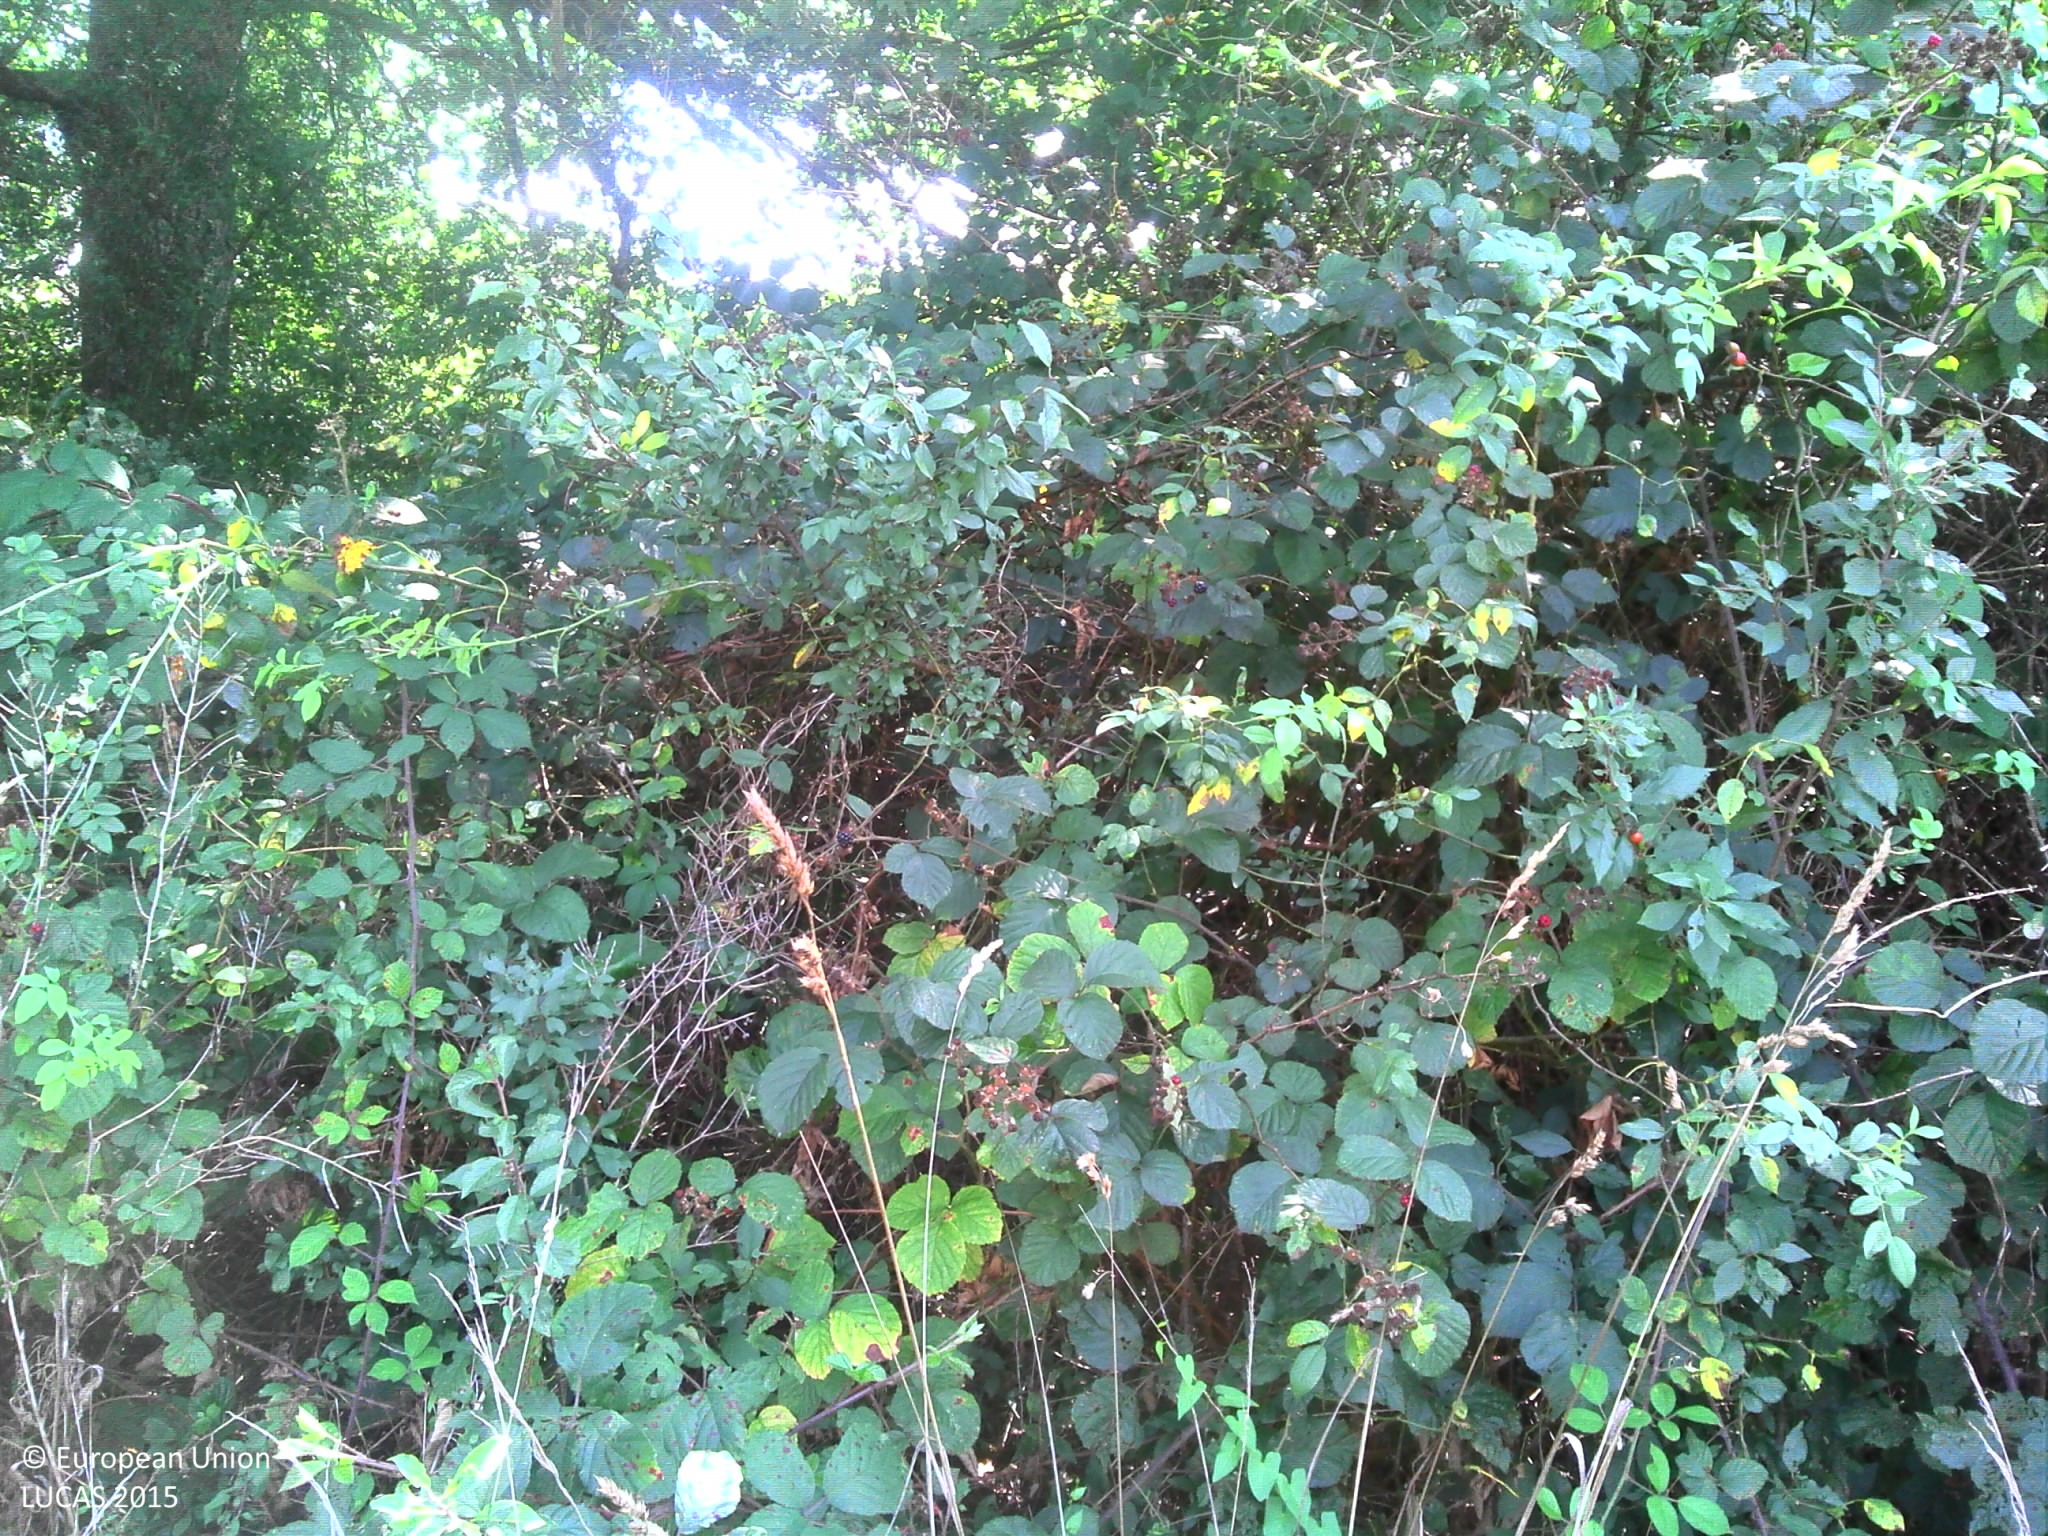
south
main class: Grassland
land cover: Grassland without tree/shrub cover
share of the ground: > 75 %
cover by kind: herbaceous plants 100 %
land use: Agriculture (excluding fallow land and kitchen gardens)
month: September
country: FR
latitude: 47.4763
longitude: 6.8569
